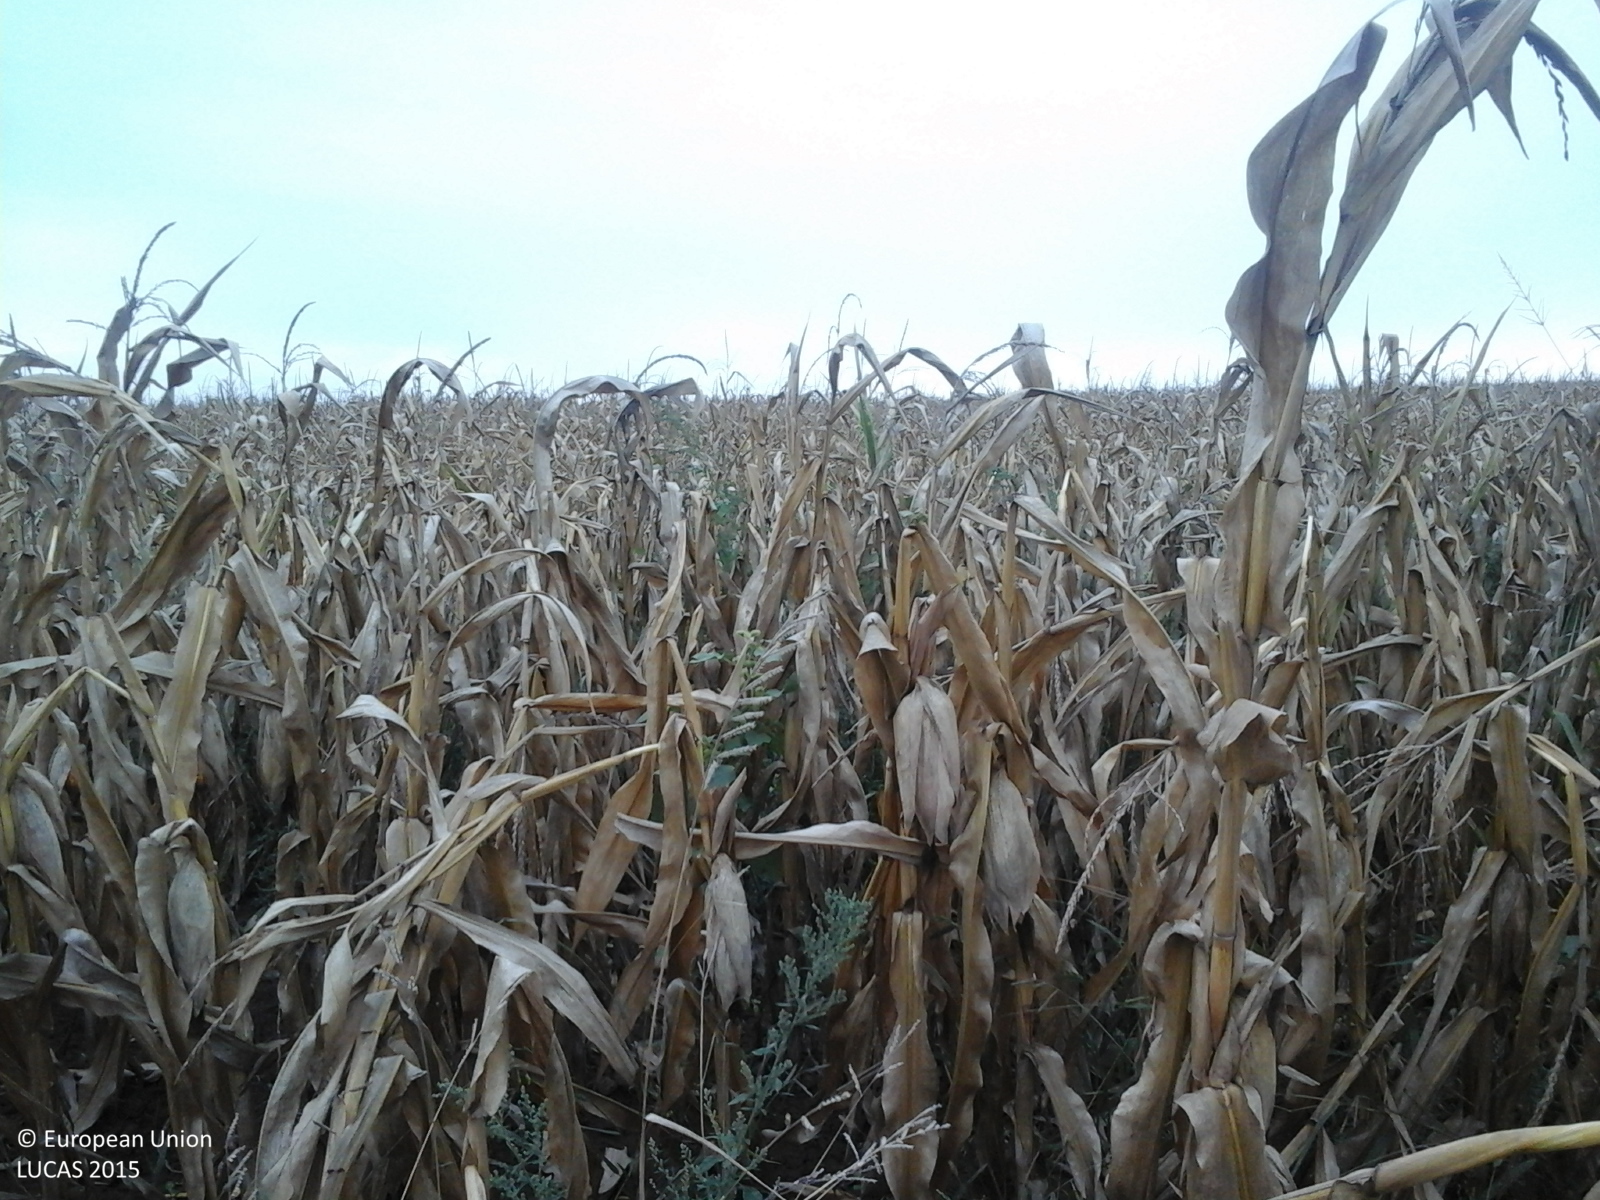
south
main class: Cropland
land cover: Maize
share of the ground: > 75 %
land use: Agriculture (excluding fallow land and kitchen gardens)
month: September
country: RO
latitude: 47.0362
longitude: 21.8497
